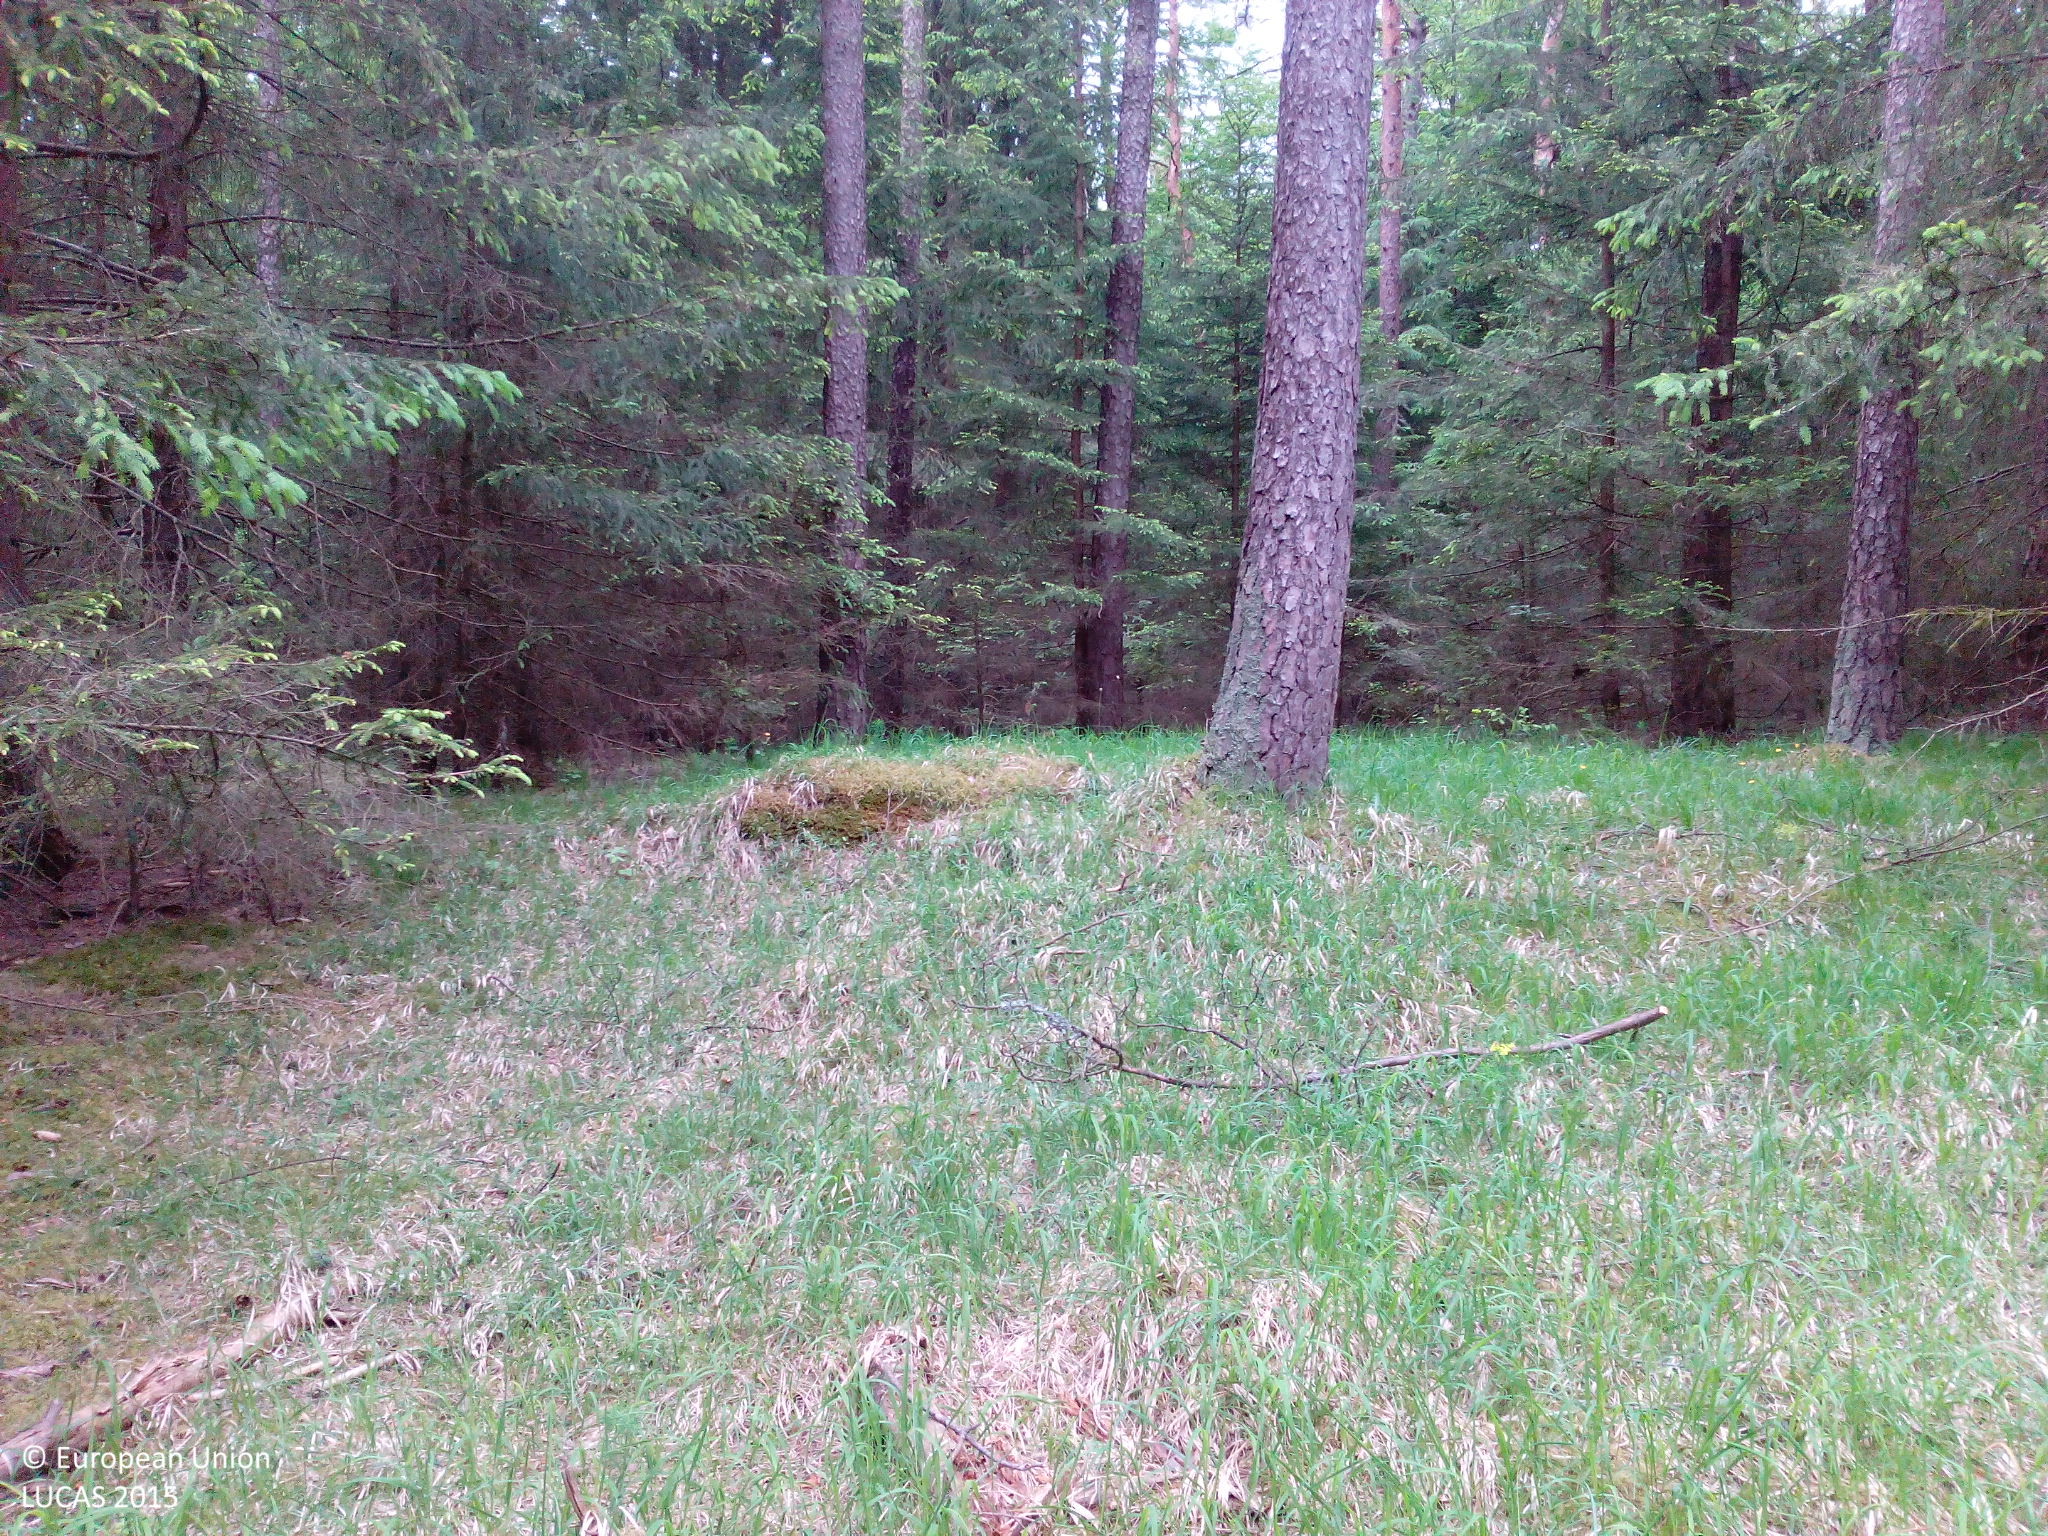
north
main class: Woodland
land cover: Other coniferous woodland
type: hemiboreal forest and nemoral coniferous forest and mixed broadleaved-coniferous forest
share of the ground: 50 - 75 %
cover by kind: coniferous forest trees 60 %, herbaceous plants 40 %
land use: Forestry
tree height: > 5 m
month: May
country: DE
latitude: 49.7609
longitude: 11.4850
